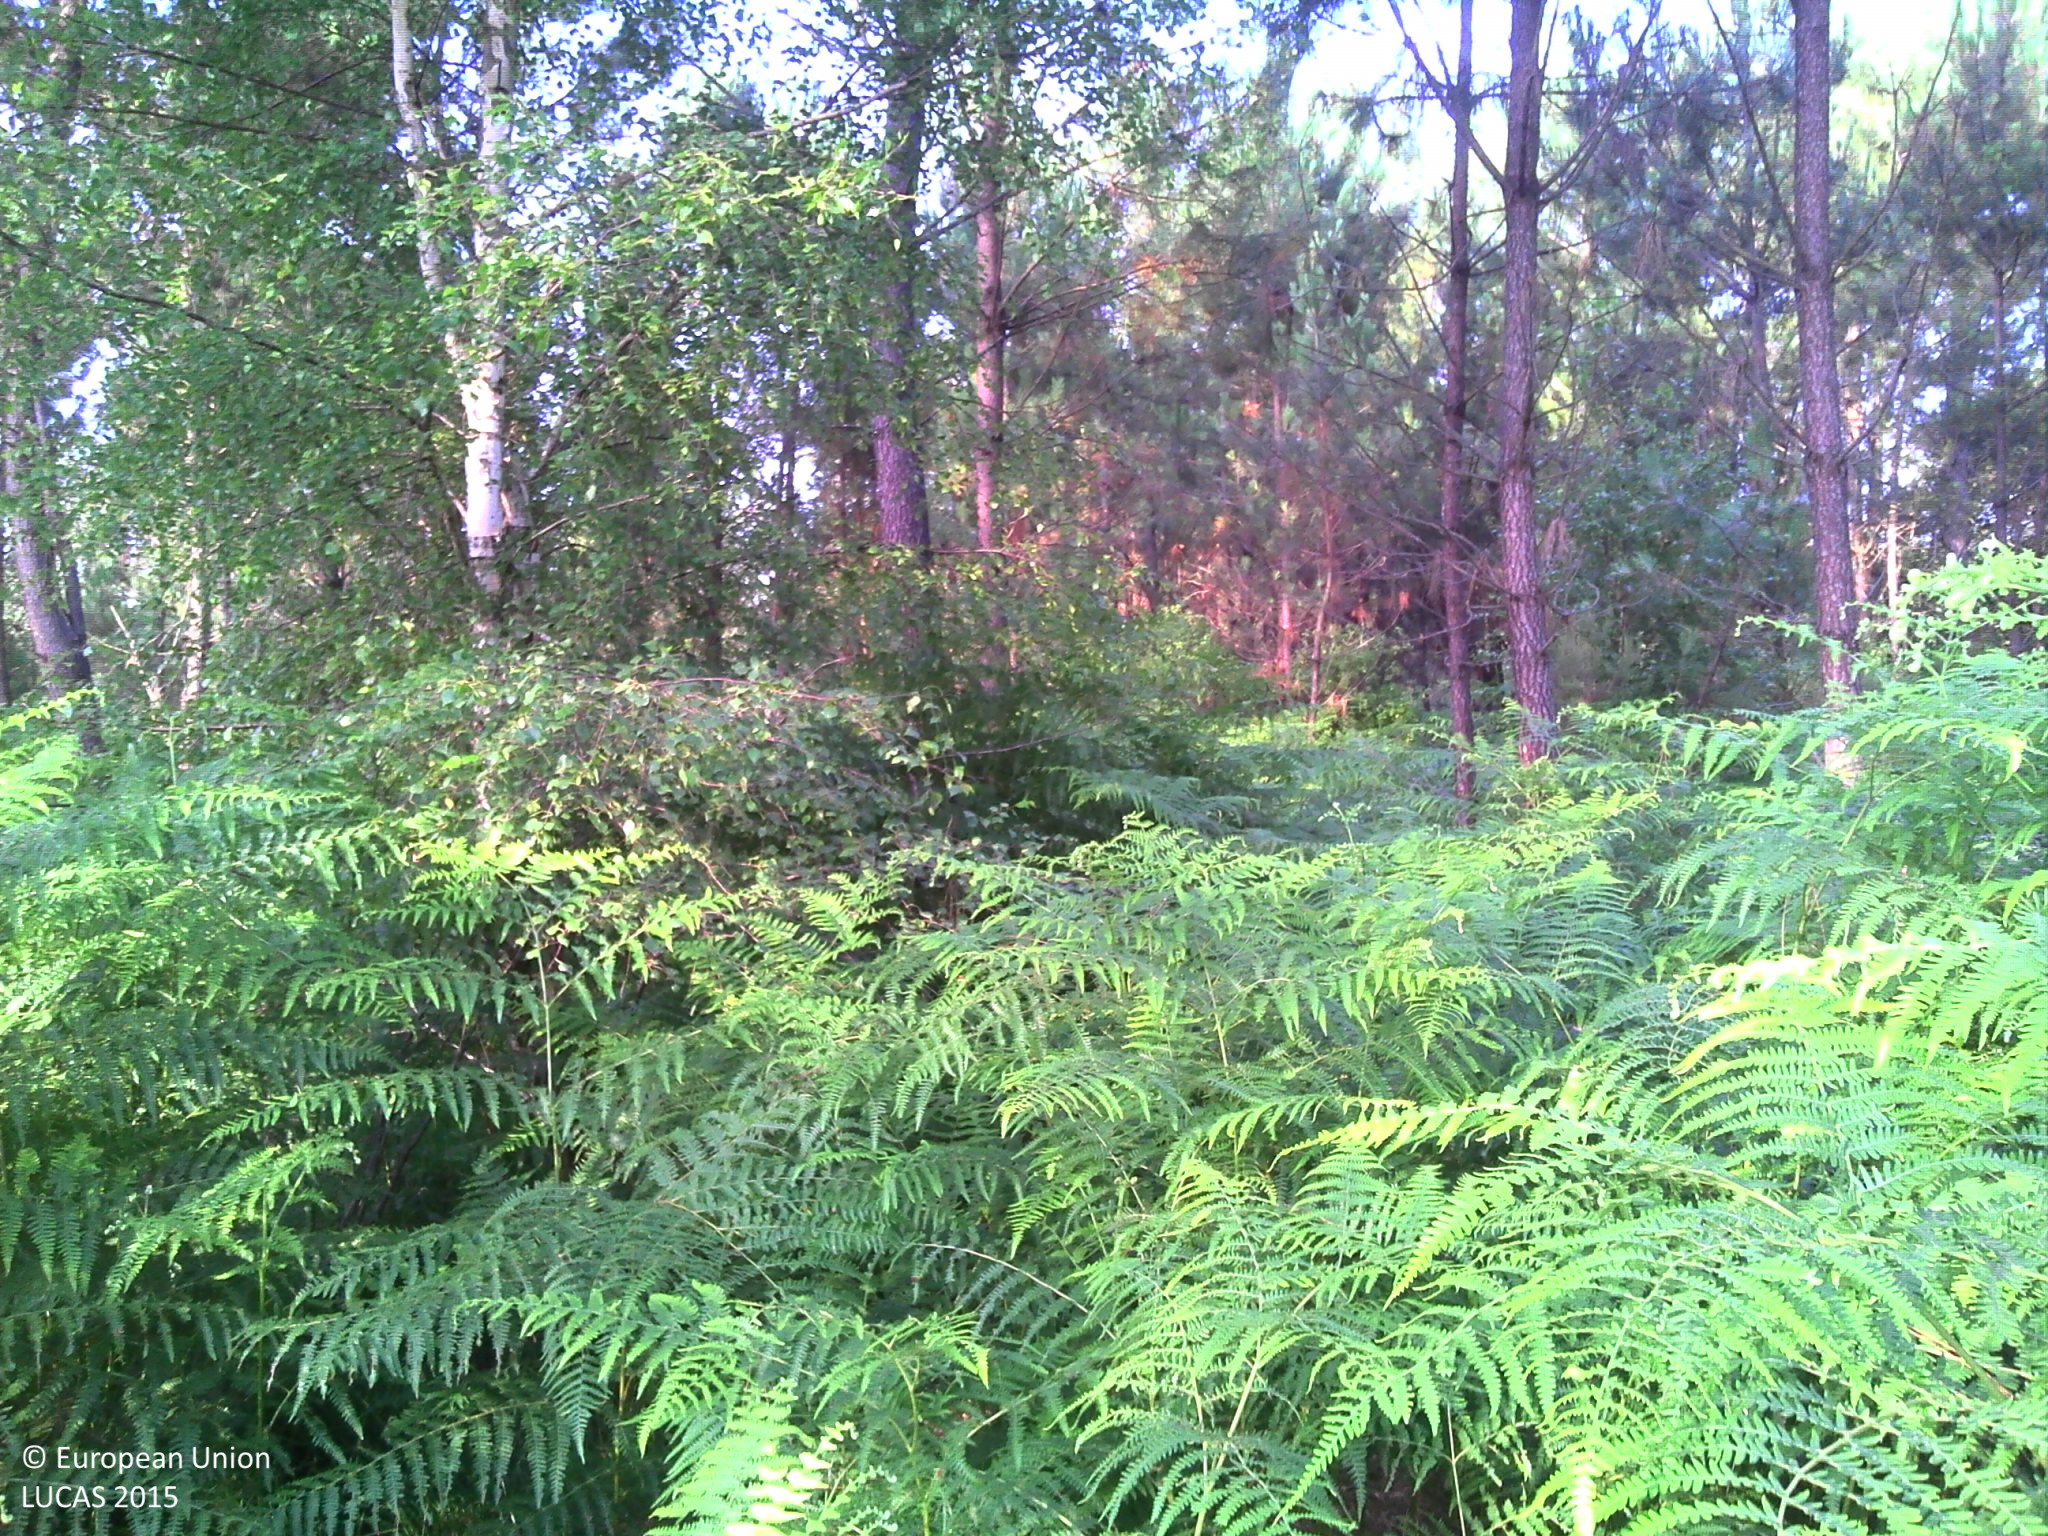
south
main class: Woodland
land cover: Pine dominated coniferous woodland
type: coniferous forest of the mediterranean region
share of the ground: > 75 %
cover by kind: coniferous forest trees 60 %, herbaceous plants 40 %
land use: Forestry
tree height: > 5 m
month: July
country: FR
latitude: 44.1179
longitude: -0.5728
